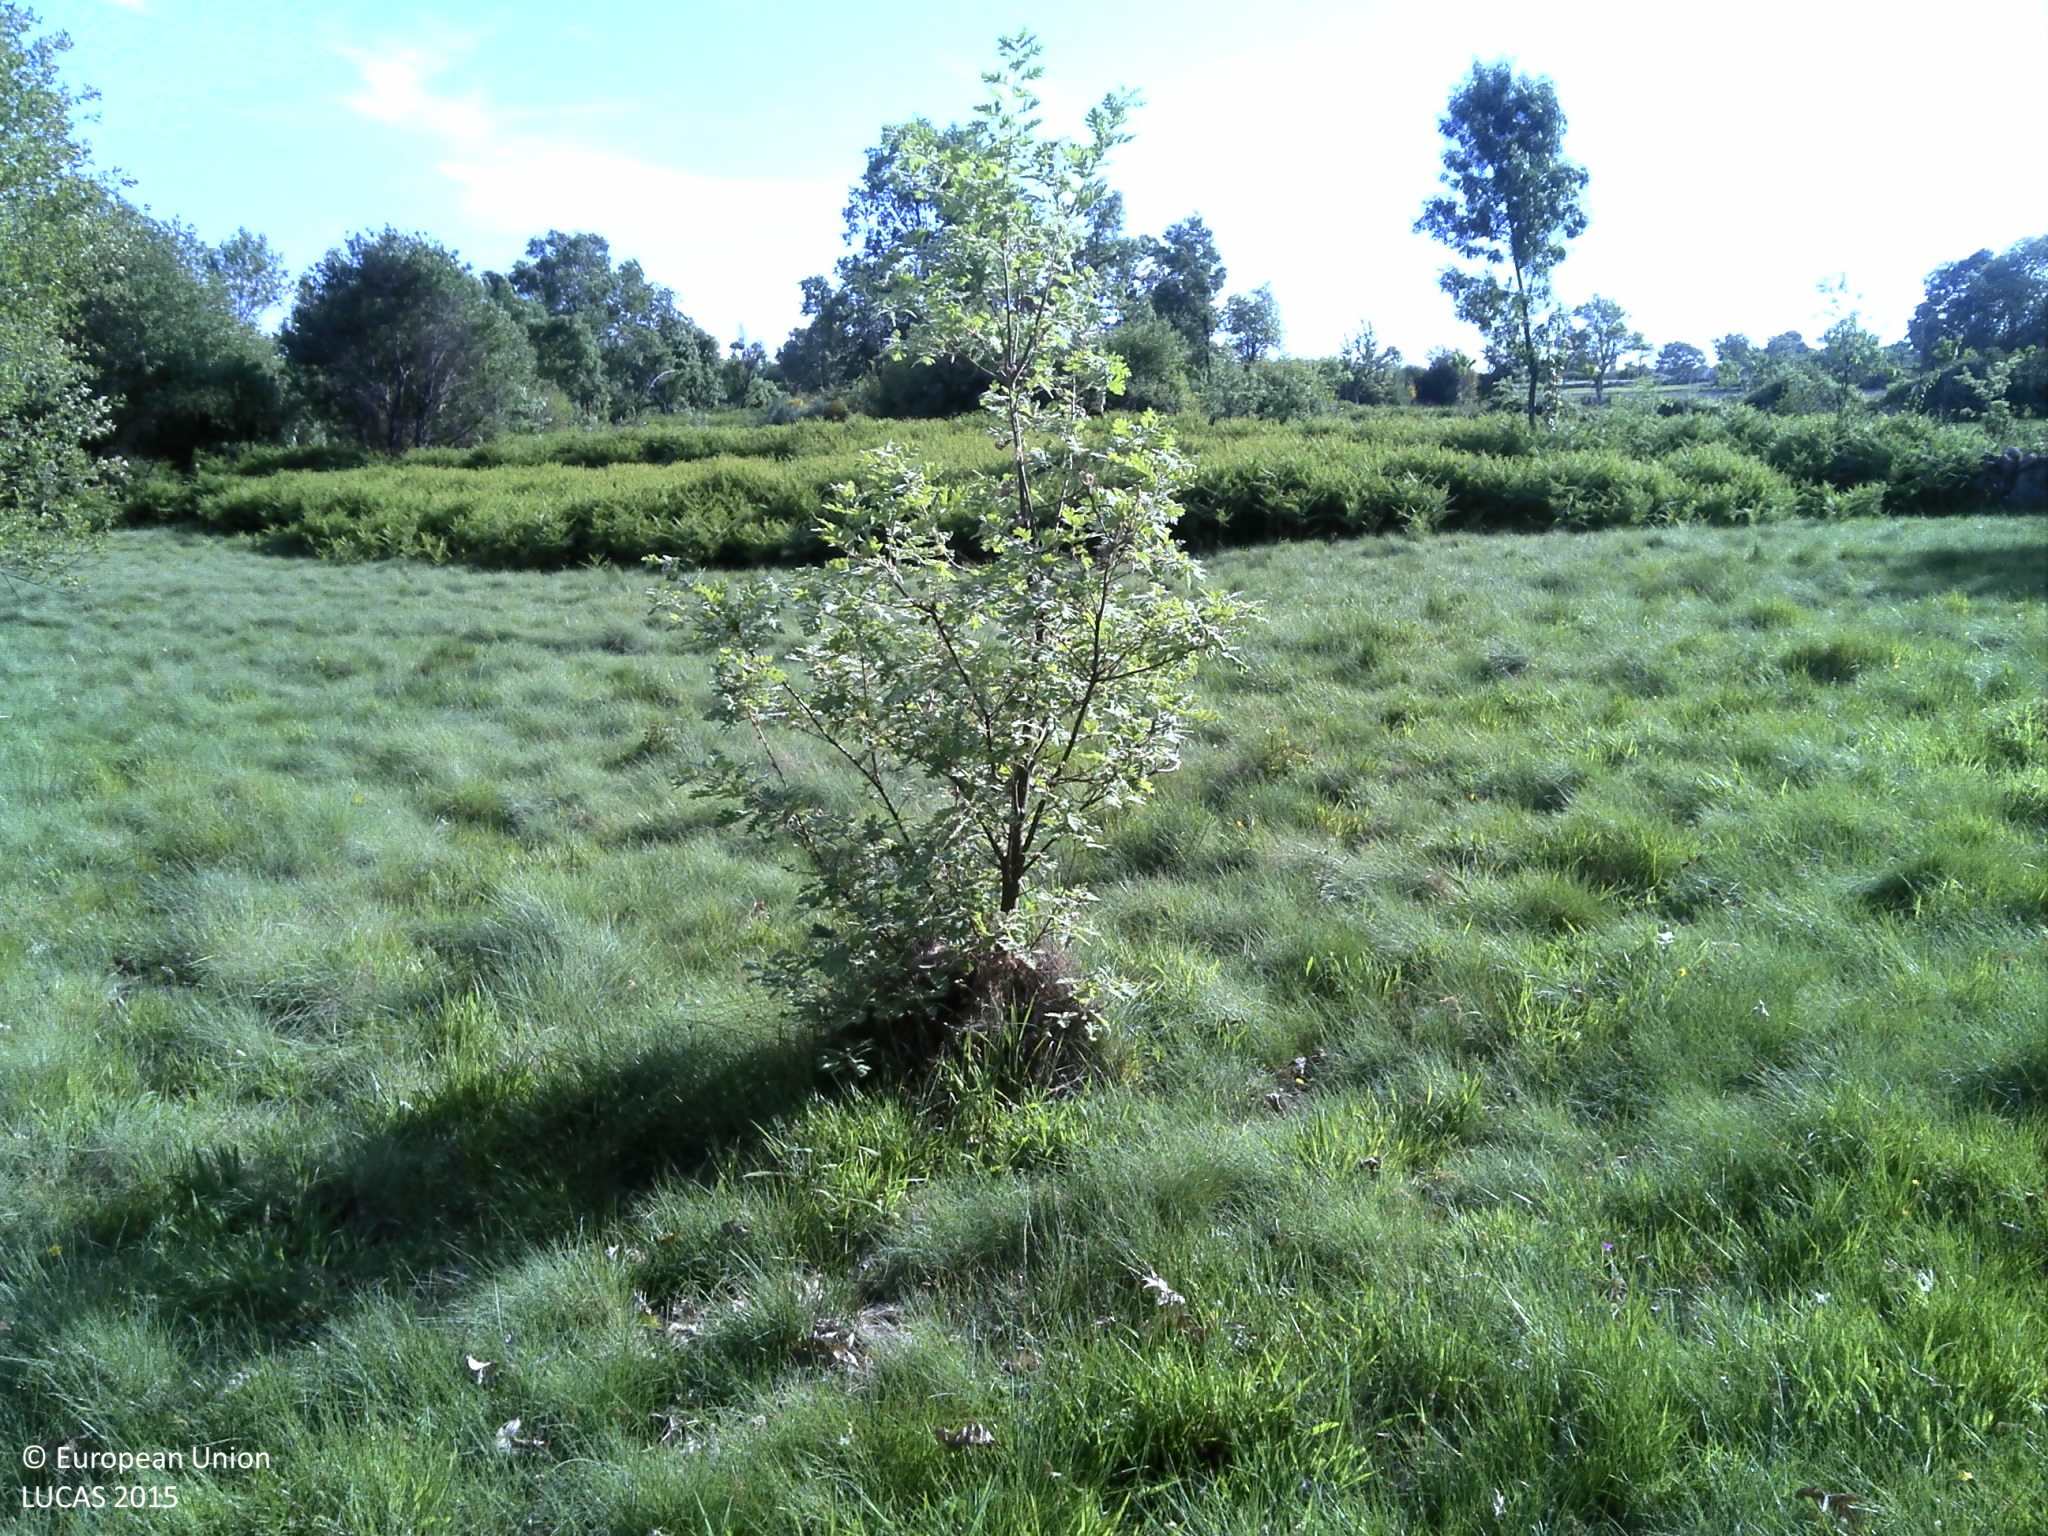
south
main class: Grassland
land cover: Grassland with sparse tree/shrub cover
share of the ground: > 75 %
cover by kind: herbaceous plants 95 %, broadleaved forest trees 5 %
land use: Agriculture (excluding fallow land and kitchen gardens)
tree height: > 5 m
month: May
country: PT
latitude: 41.6794
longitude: -7.3400
